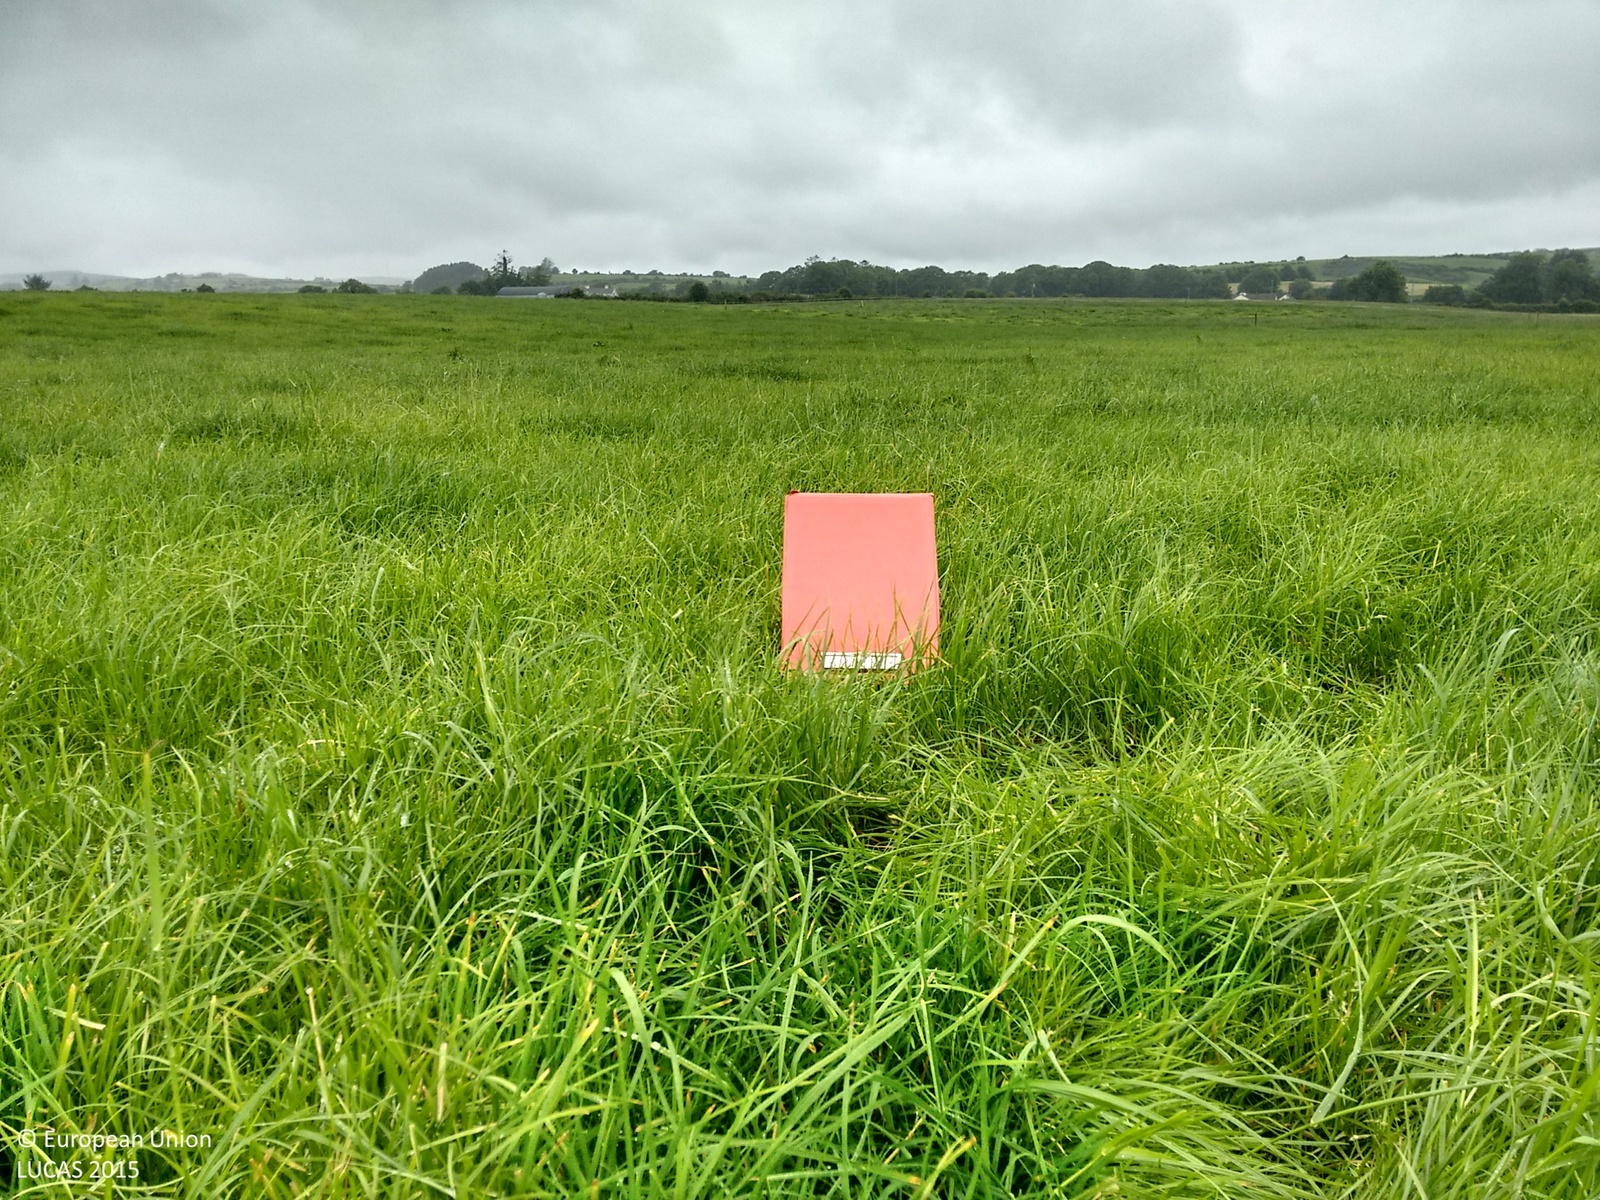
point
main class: Grassland
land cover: Grassland without tree/shrub cover
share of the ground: > 75 %
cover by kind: herbaceous plants 95 %, shrubs 5 %
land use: Agriculture (excluding fallow land and kitchen gardens)
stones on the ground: < 10 %
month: July
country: IE
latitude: 51.6512
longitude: -9.0175
